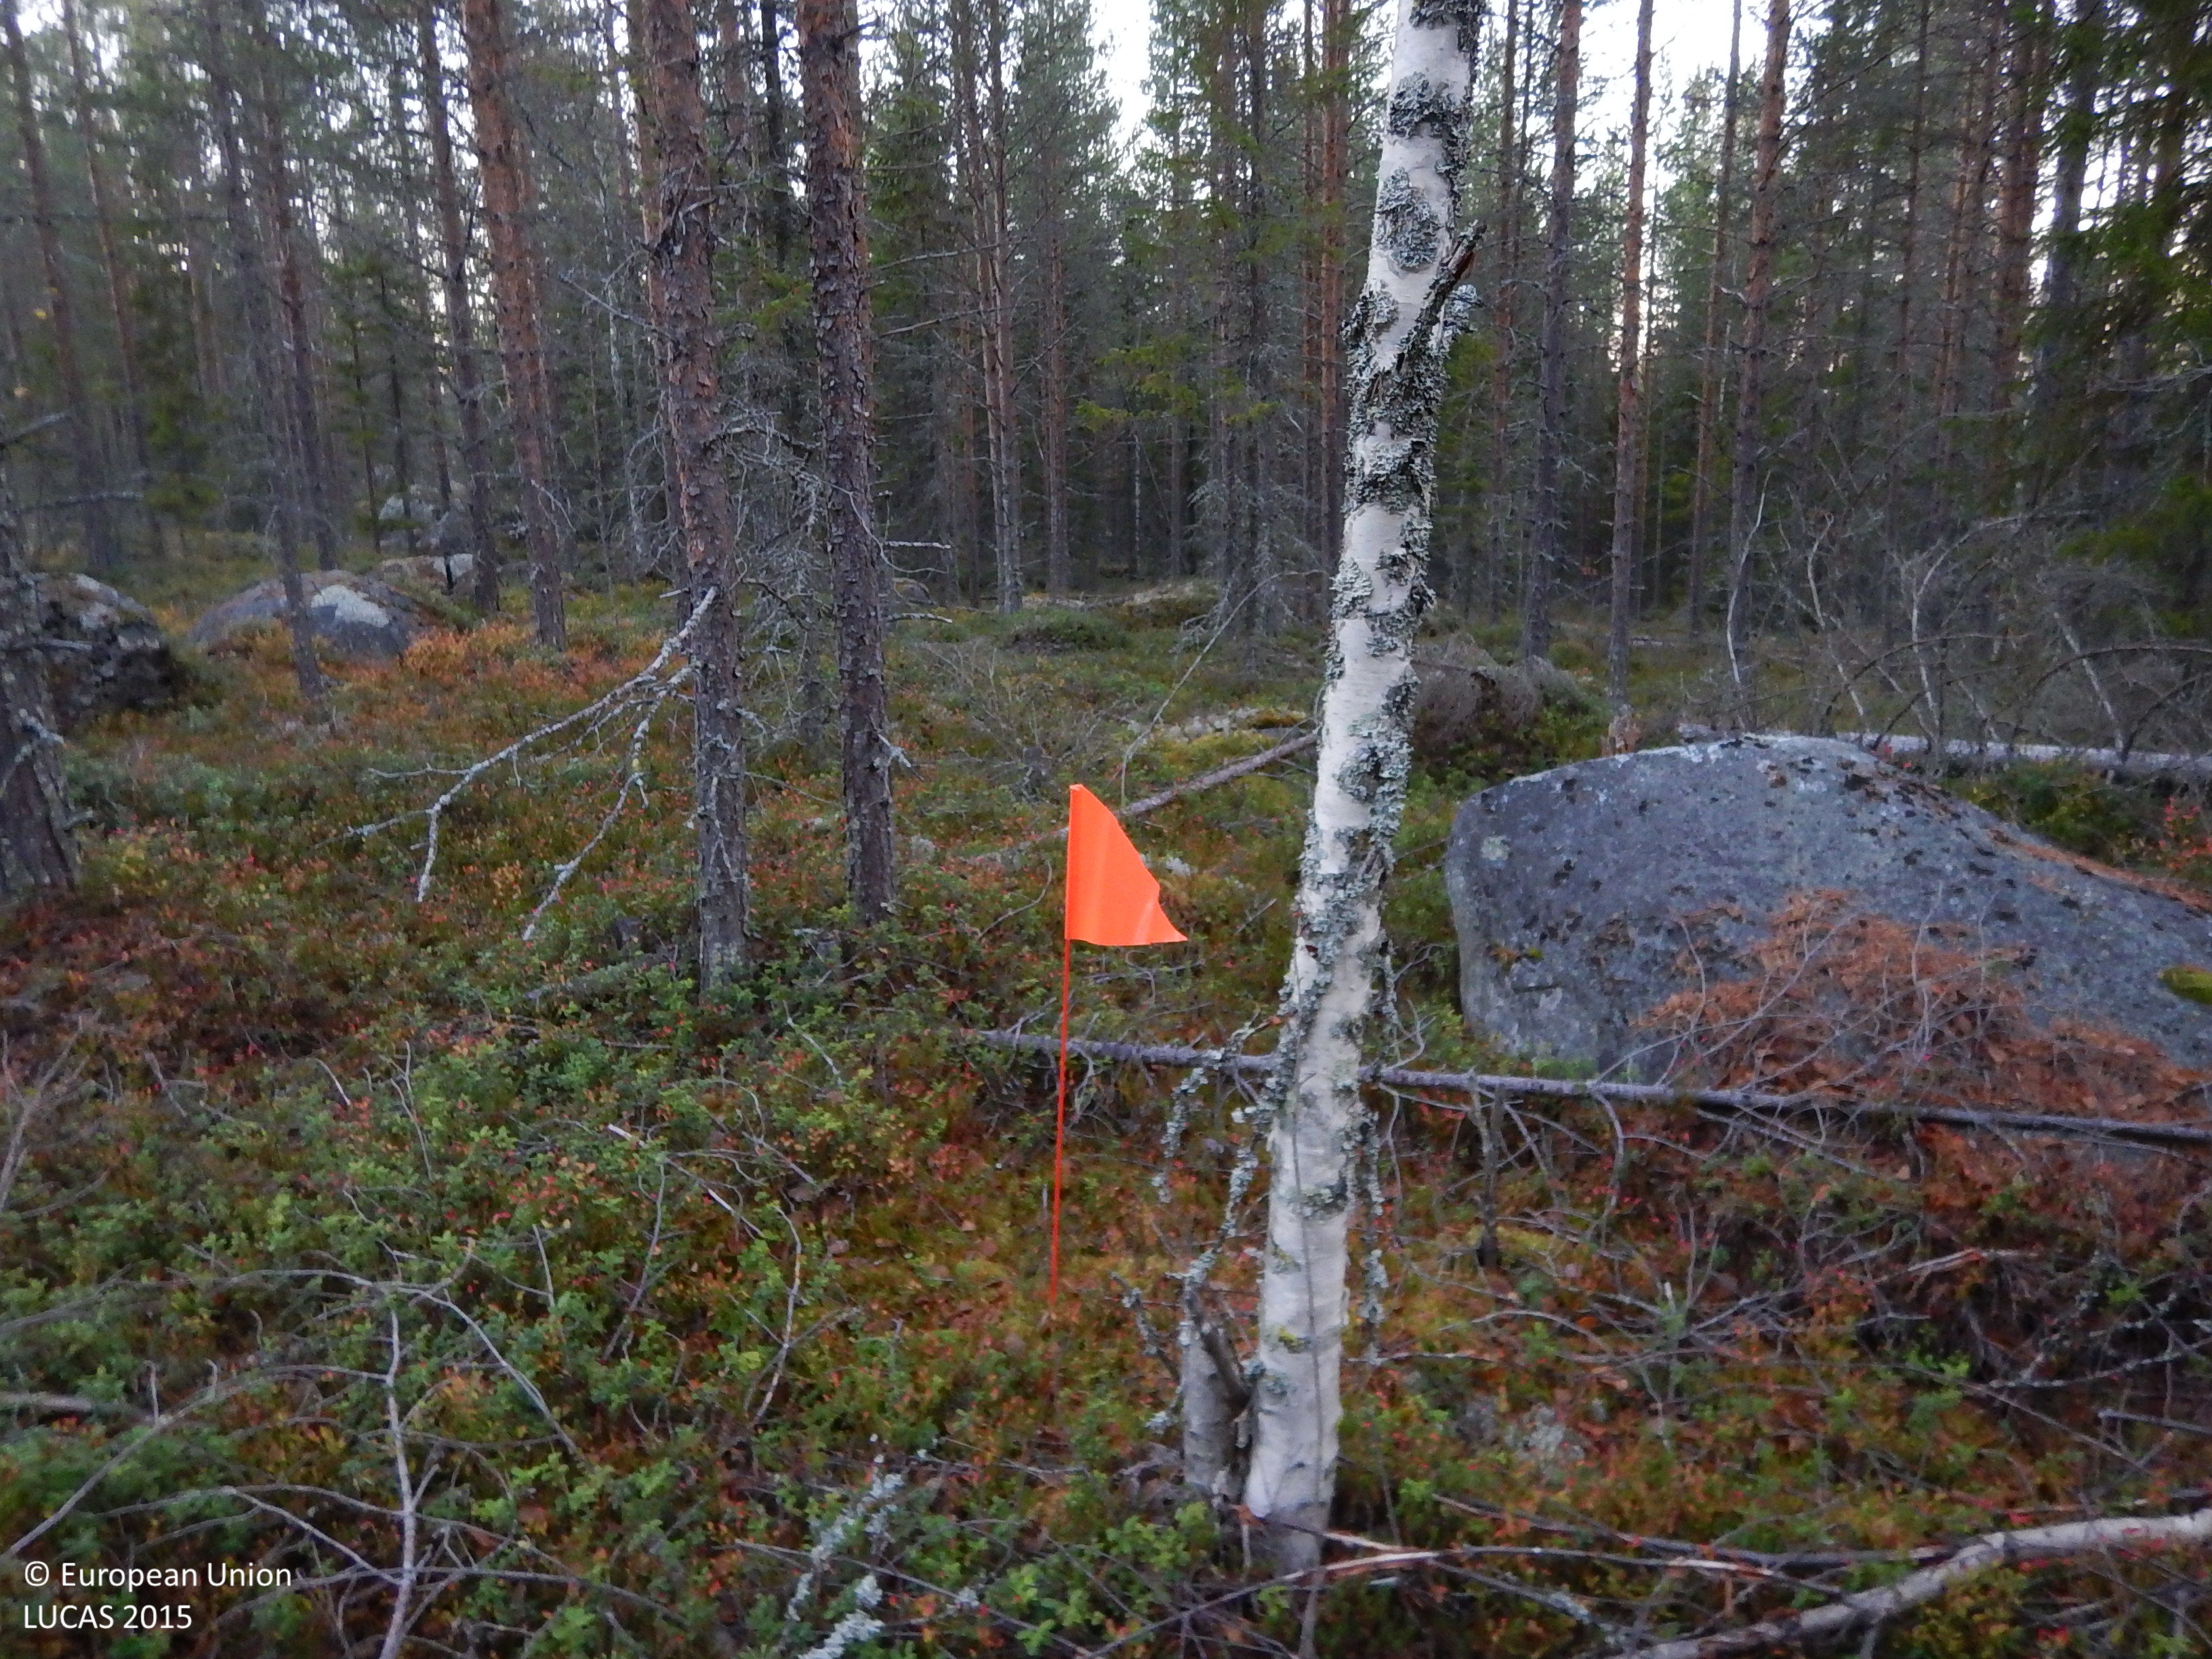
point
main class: Woodland
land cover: Pine dominated coniferous woodland
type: boreal forest
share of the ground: 50 - 75 %
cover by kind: coniferous forest trees 45 %, shrubs 20 %, lichens and mosses 20 %, broadleaved forest trees 5 %, herbaceous plants 5 %, consolidated bare surface 5 %
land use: Forestry
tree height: > 5 m
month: October
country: SE
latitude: 64.9317
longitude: 20.9543
